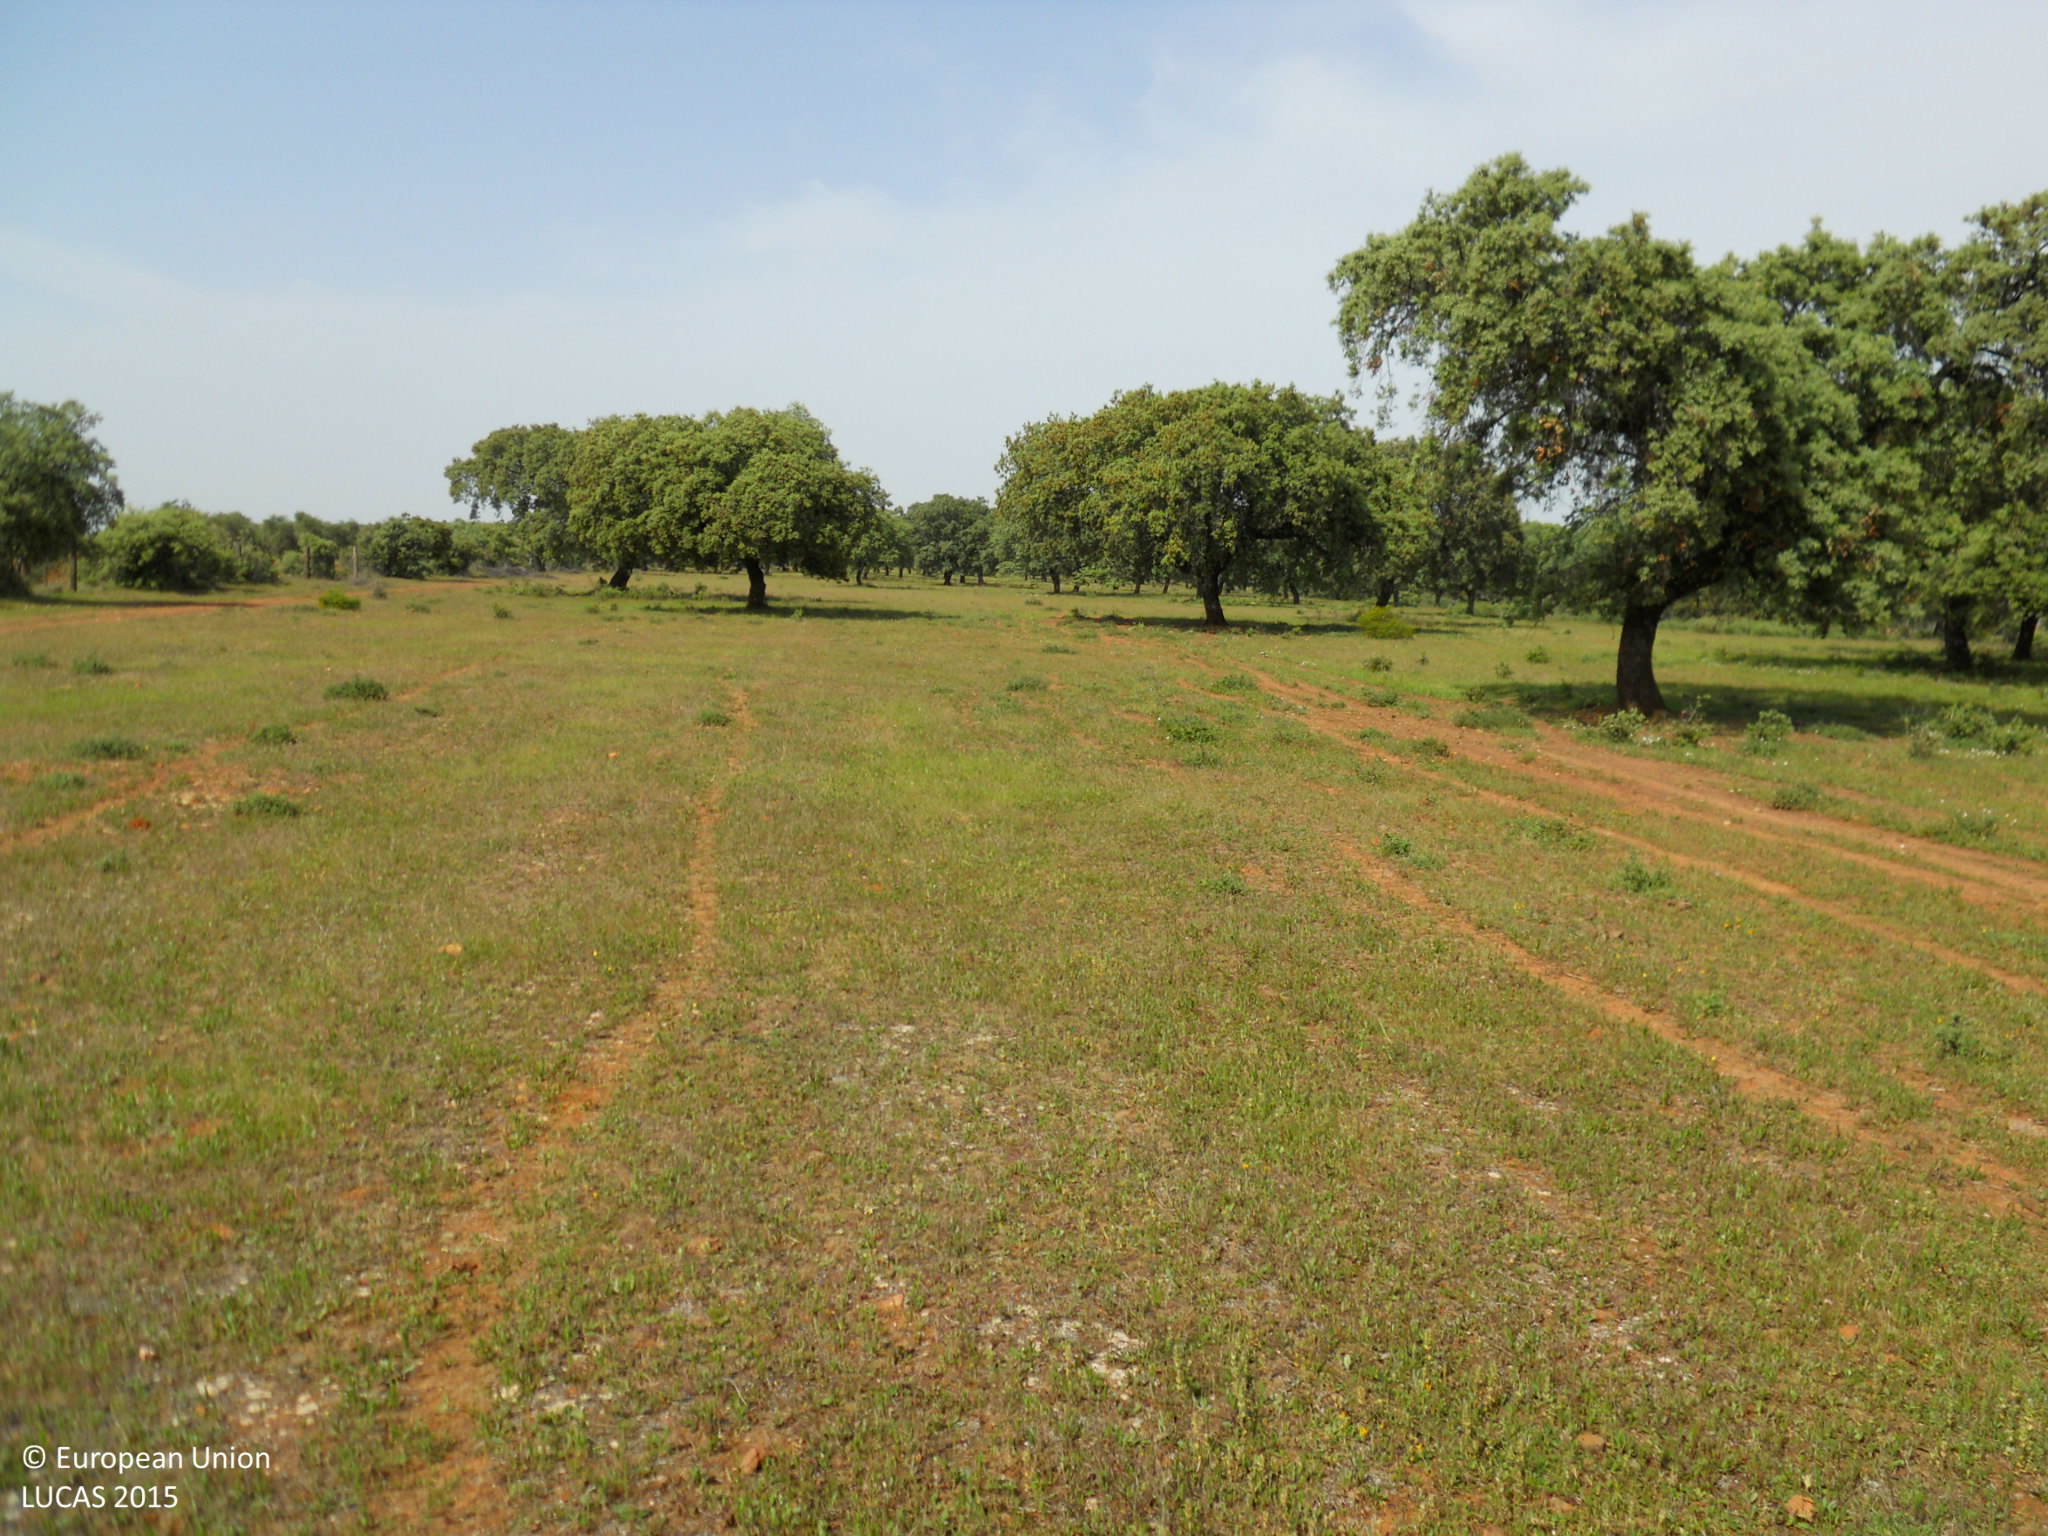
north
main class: Woodland
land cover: Broadleaved woodland
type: broadleaved evergreen forest
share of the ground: 25 - 50 %
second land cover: Grassland without tree/shrub cover
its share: > 75 %
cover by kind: herbaceous plants 75 %, broadleaved forest trees 25 %
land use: Forestry
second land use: Agriculture (excluding fallow land and kitchen gardens)
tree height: > 5 m
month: April
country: ES
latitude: 39.1408
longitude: -6.3636
